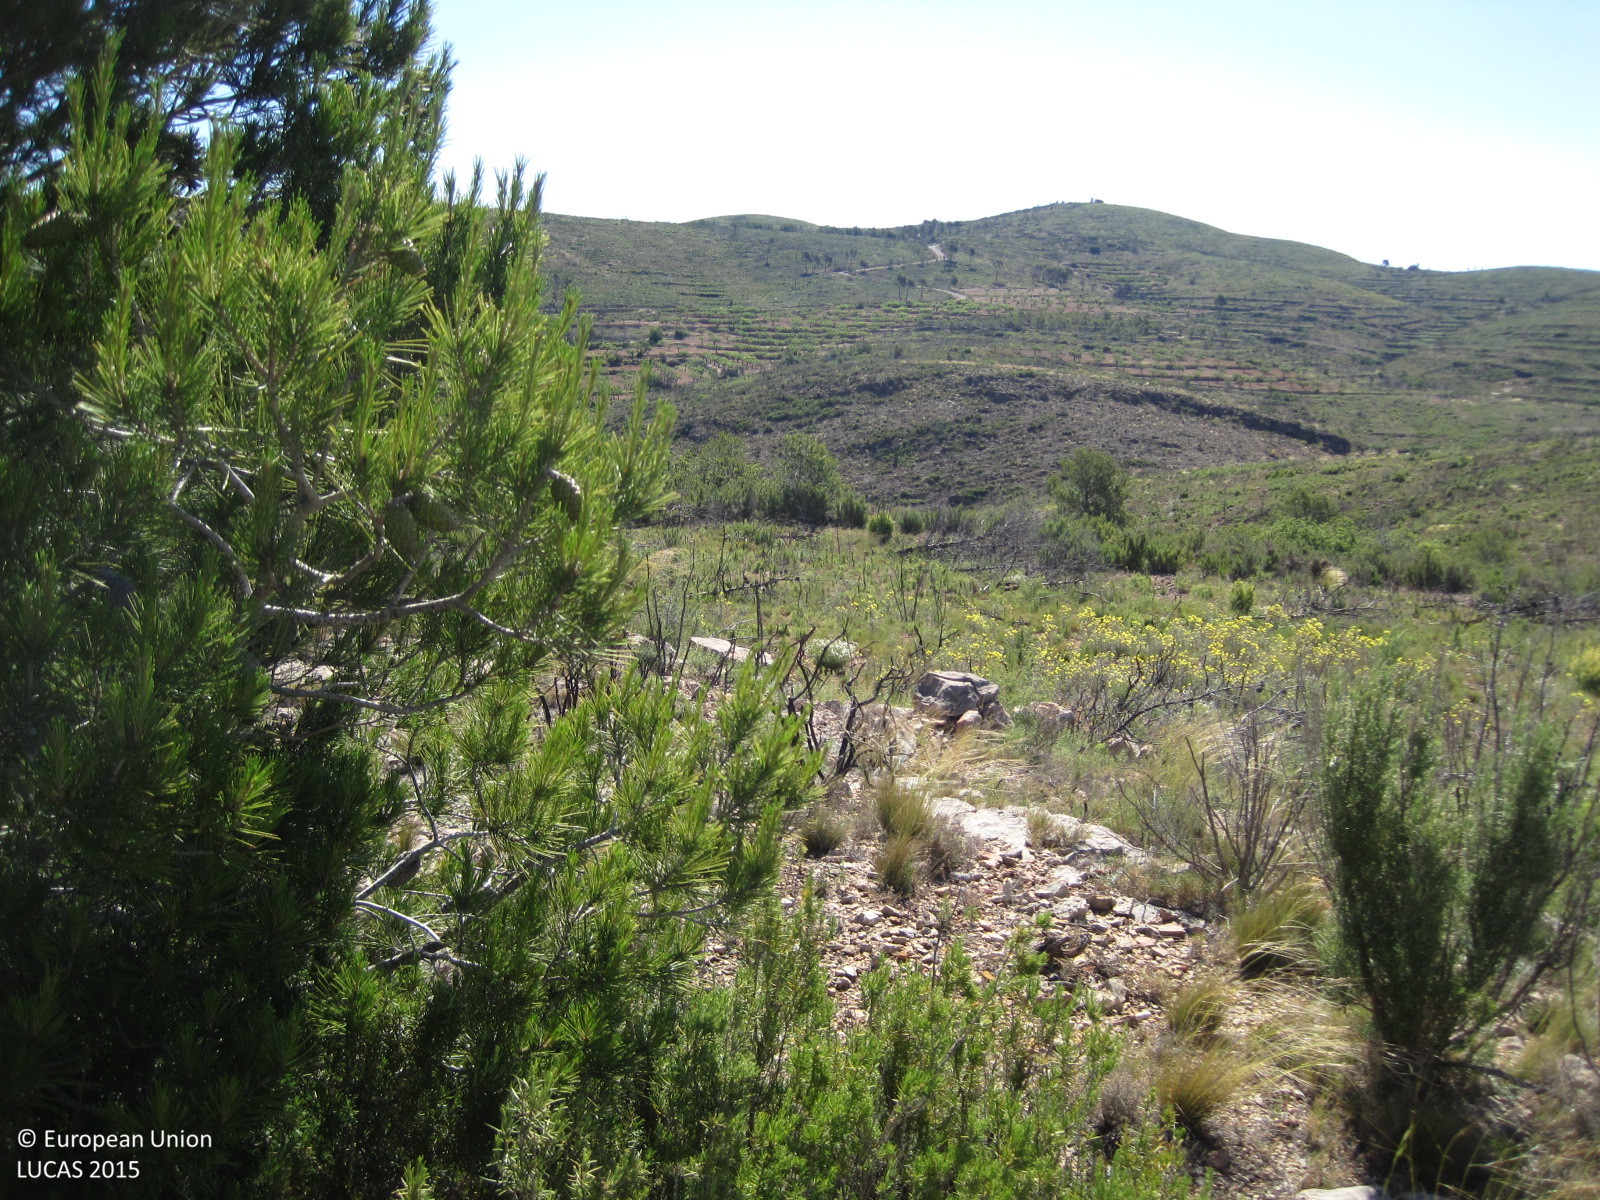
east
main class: Shrubland
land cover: Shrubland with sparse tree cover
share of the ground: 50 - 75 %
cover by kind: shrubs 60 %, consolidated bare surface 25 %, herbaceous plants 10 %, coniferous forest trees 5 %
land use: Semi-natural and natural areas not in use
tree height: > 5 m
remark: Burnt area
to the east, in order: Shrubland with sparse tree cover; Shrubland without tree cover; Grassland with sparse tree/shrub cover; Shrubland without tree cover; Dry stone walls; Grassland without tree/shrub cover; Shrubland without tree cover
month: May
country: ES
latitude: 39.7759
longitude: -0.6614
